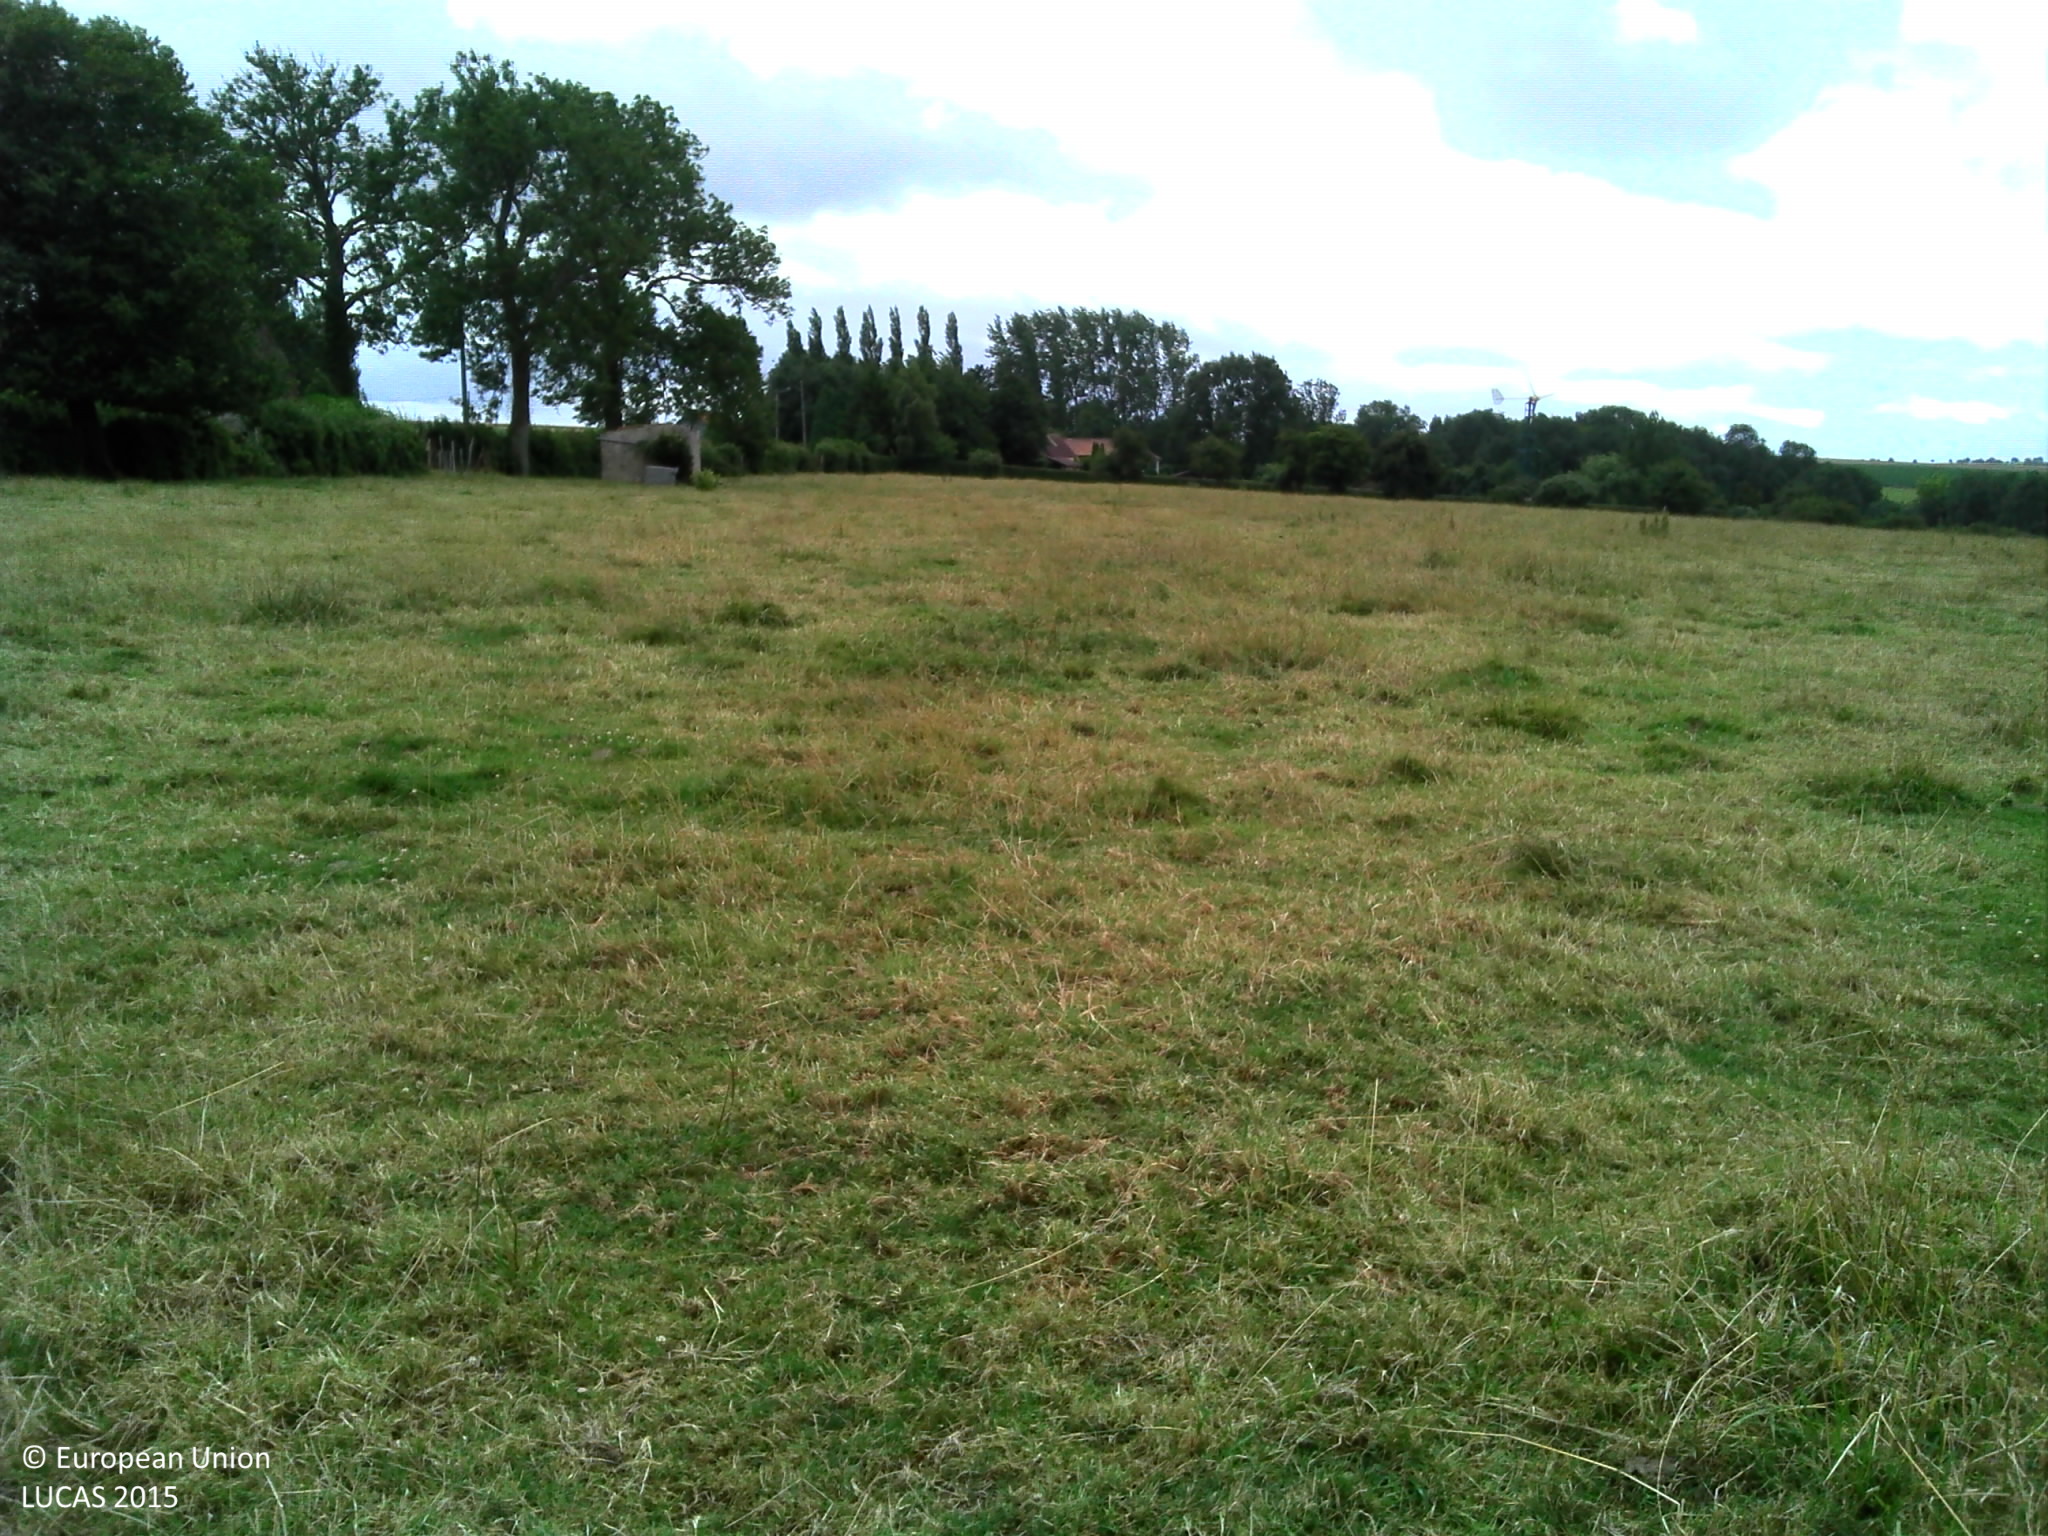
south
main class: Grassland
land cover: Grassland without tree/shrub cover
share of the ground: > 75 %
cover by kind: herbaceous plants 100 %
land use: Agriculture (excluding fallow land and kitchen gardens)
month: July
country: FR
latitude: 50.6709
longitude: 2.1320
